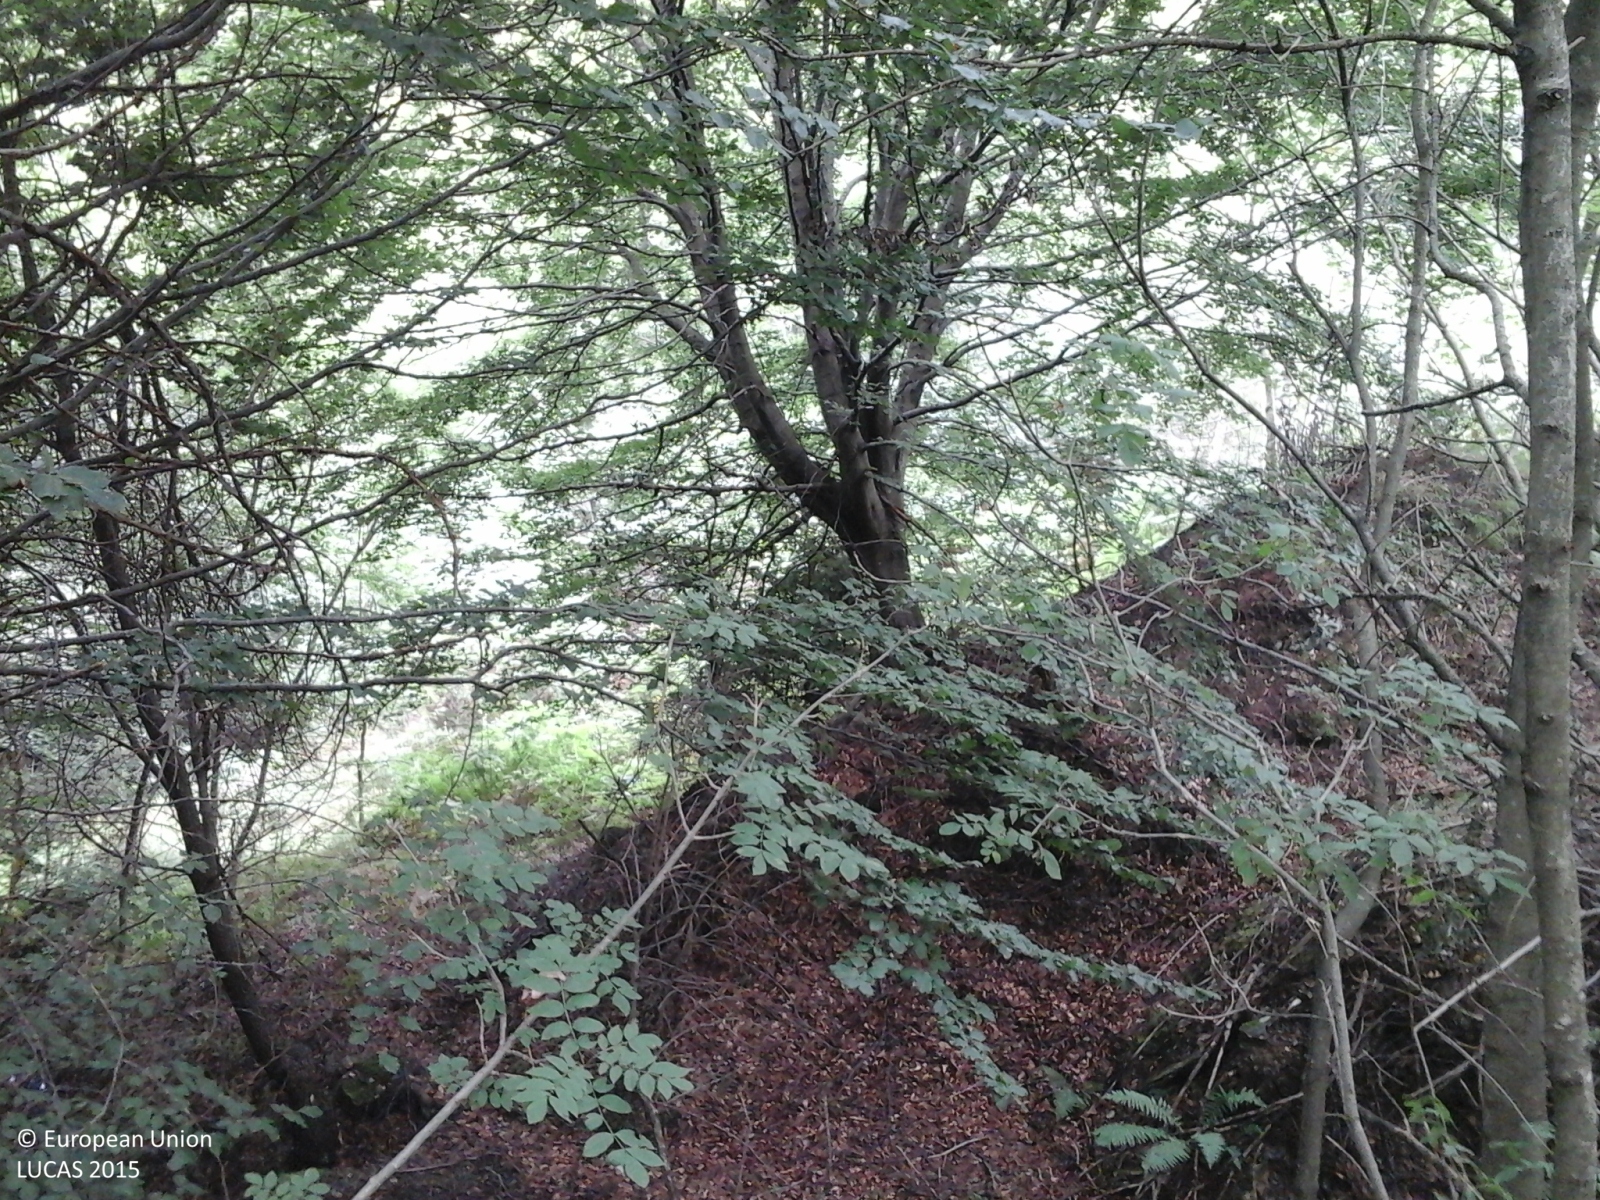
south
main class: Woodland
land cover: Broadleaved woodland
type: mountainous beech forest
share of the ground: > 75 %
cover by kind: broadleaved forest trees 80 %, coniferous forest trees 10 %, herbaceous plants 10 %
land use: Forestry
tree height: > 5 m
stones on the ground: < 10 %
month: August
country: IT
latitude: 46.0773
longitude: 9.1091
